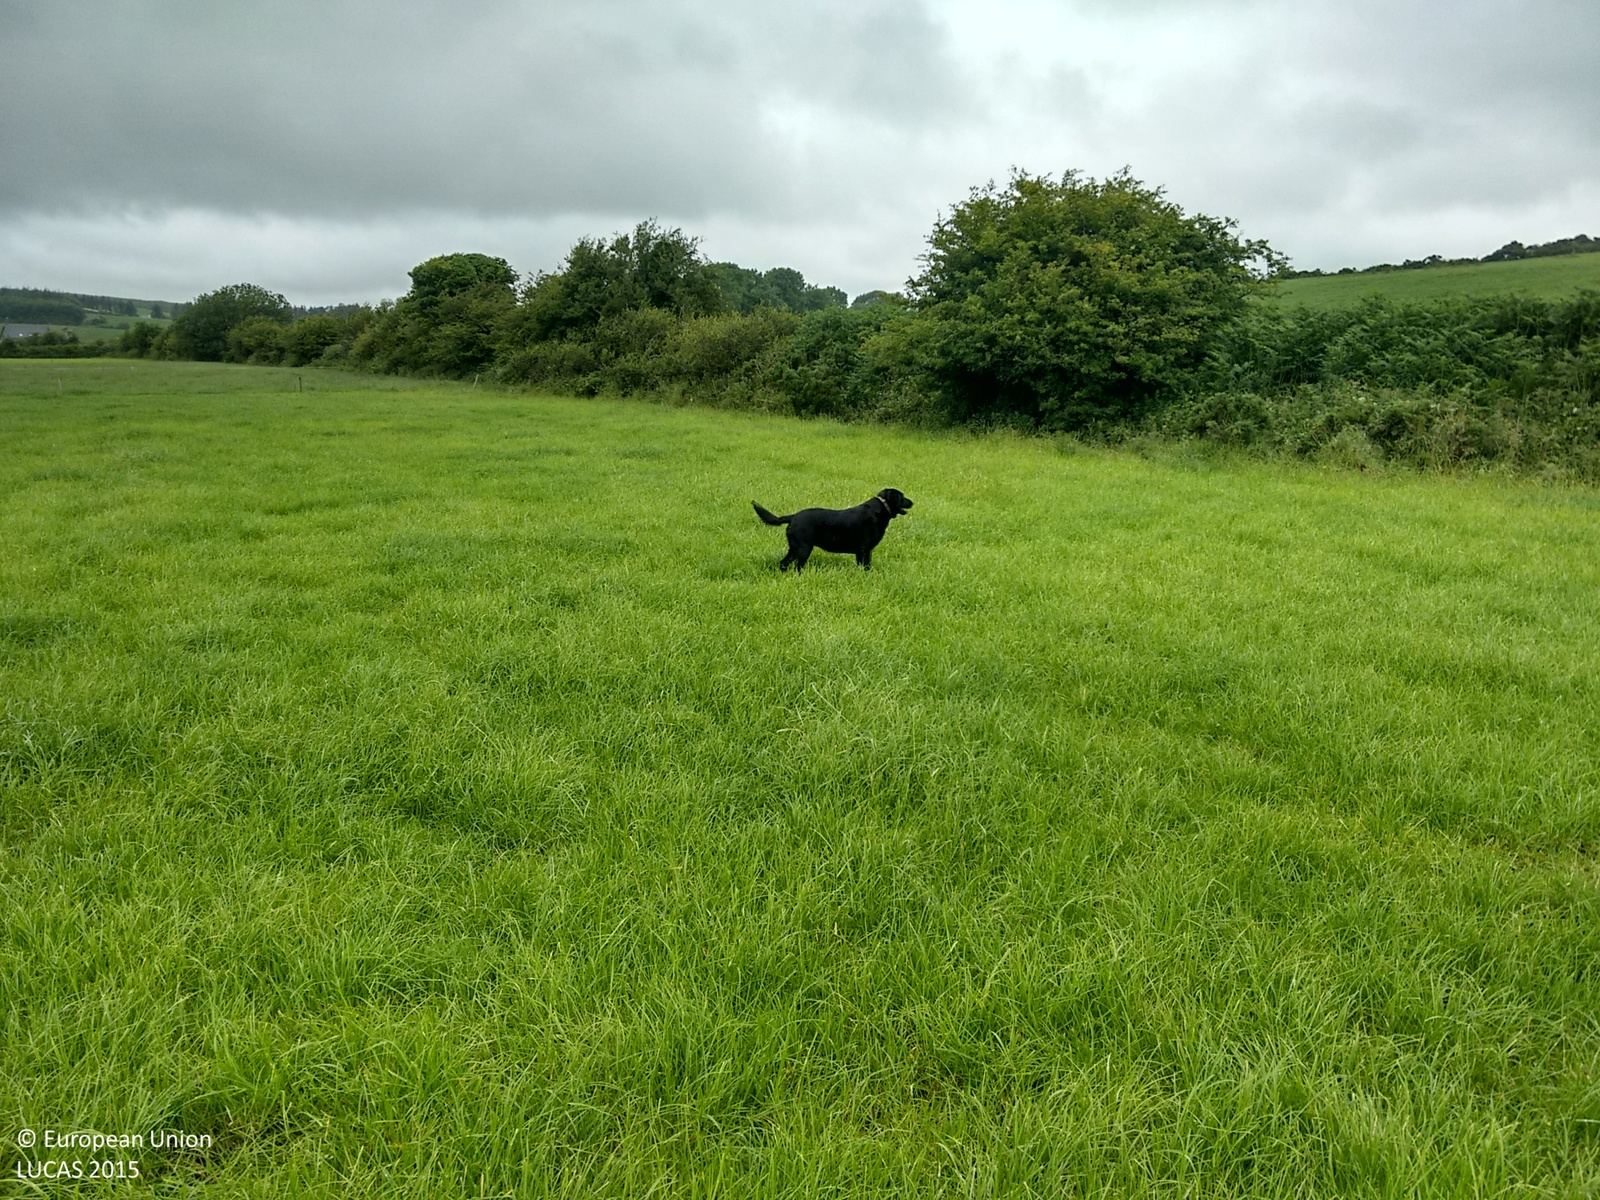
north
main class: Grassland
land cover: Grassland without tree/shrub cover
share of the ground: > 75 %
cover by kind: herbaceous plants 95 %, shrubs 5 %
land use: Agriculture (excluding fallow land and kitchen gardens)
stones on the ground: < 10 %
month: July
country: IE
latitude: 51.6512
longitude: -9.0175
